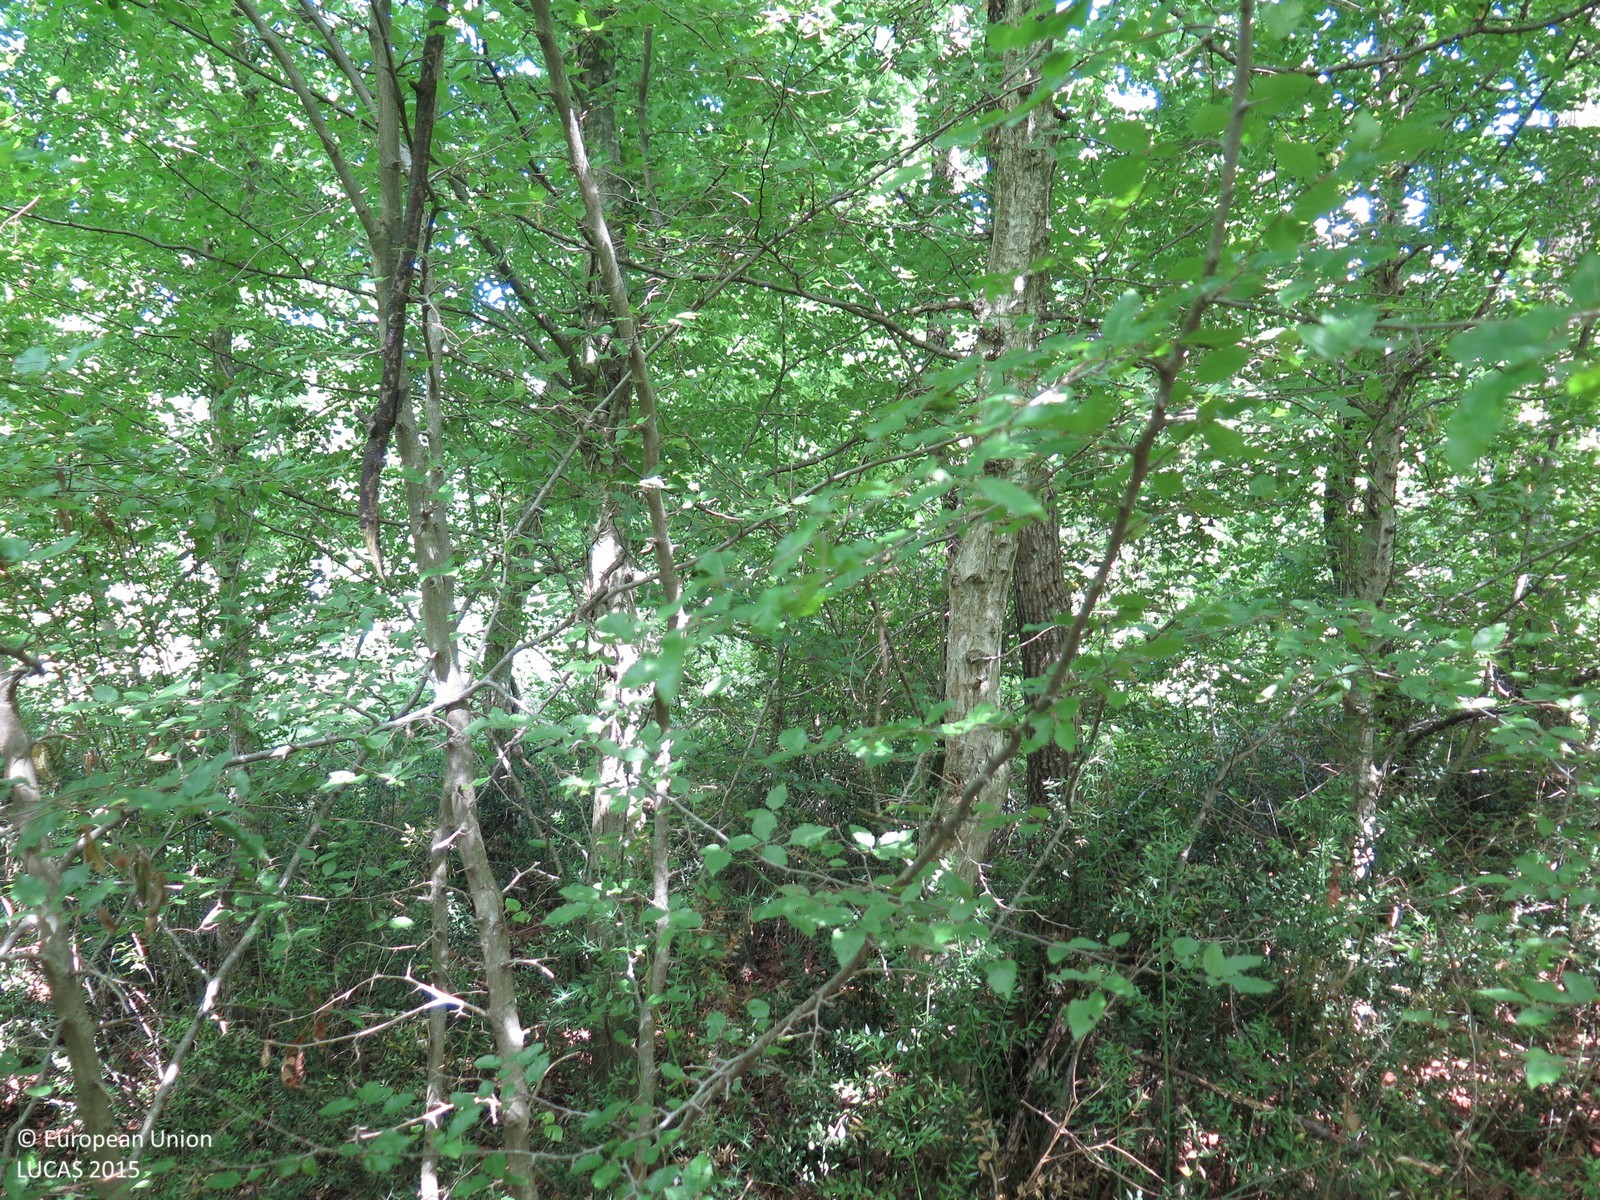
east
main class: Woodland
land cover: Broadleaved woodland
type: beech forest
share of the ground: > 75 %
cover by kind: broadleaved forest trees 90 %, shrubs 5 %, herbaceous plants 5 %
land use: Semi-natural and natural areas not in use
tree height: > 5 m
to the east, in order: Broadleaved woodland; Tracks; Broadleaved woodland; Tracks; Shruby margins; Spontaneously vegetated surfaces; Abandoned hedges; Grassland without tree/shrub cover; Olive groves
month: June
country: HR
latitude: 45.2608
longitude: 13.6524
